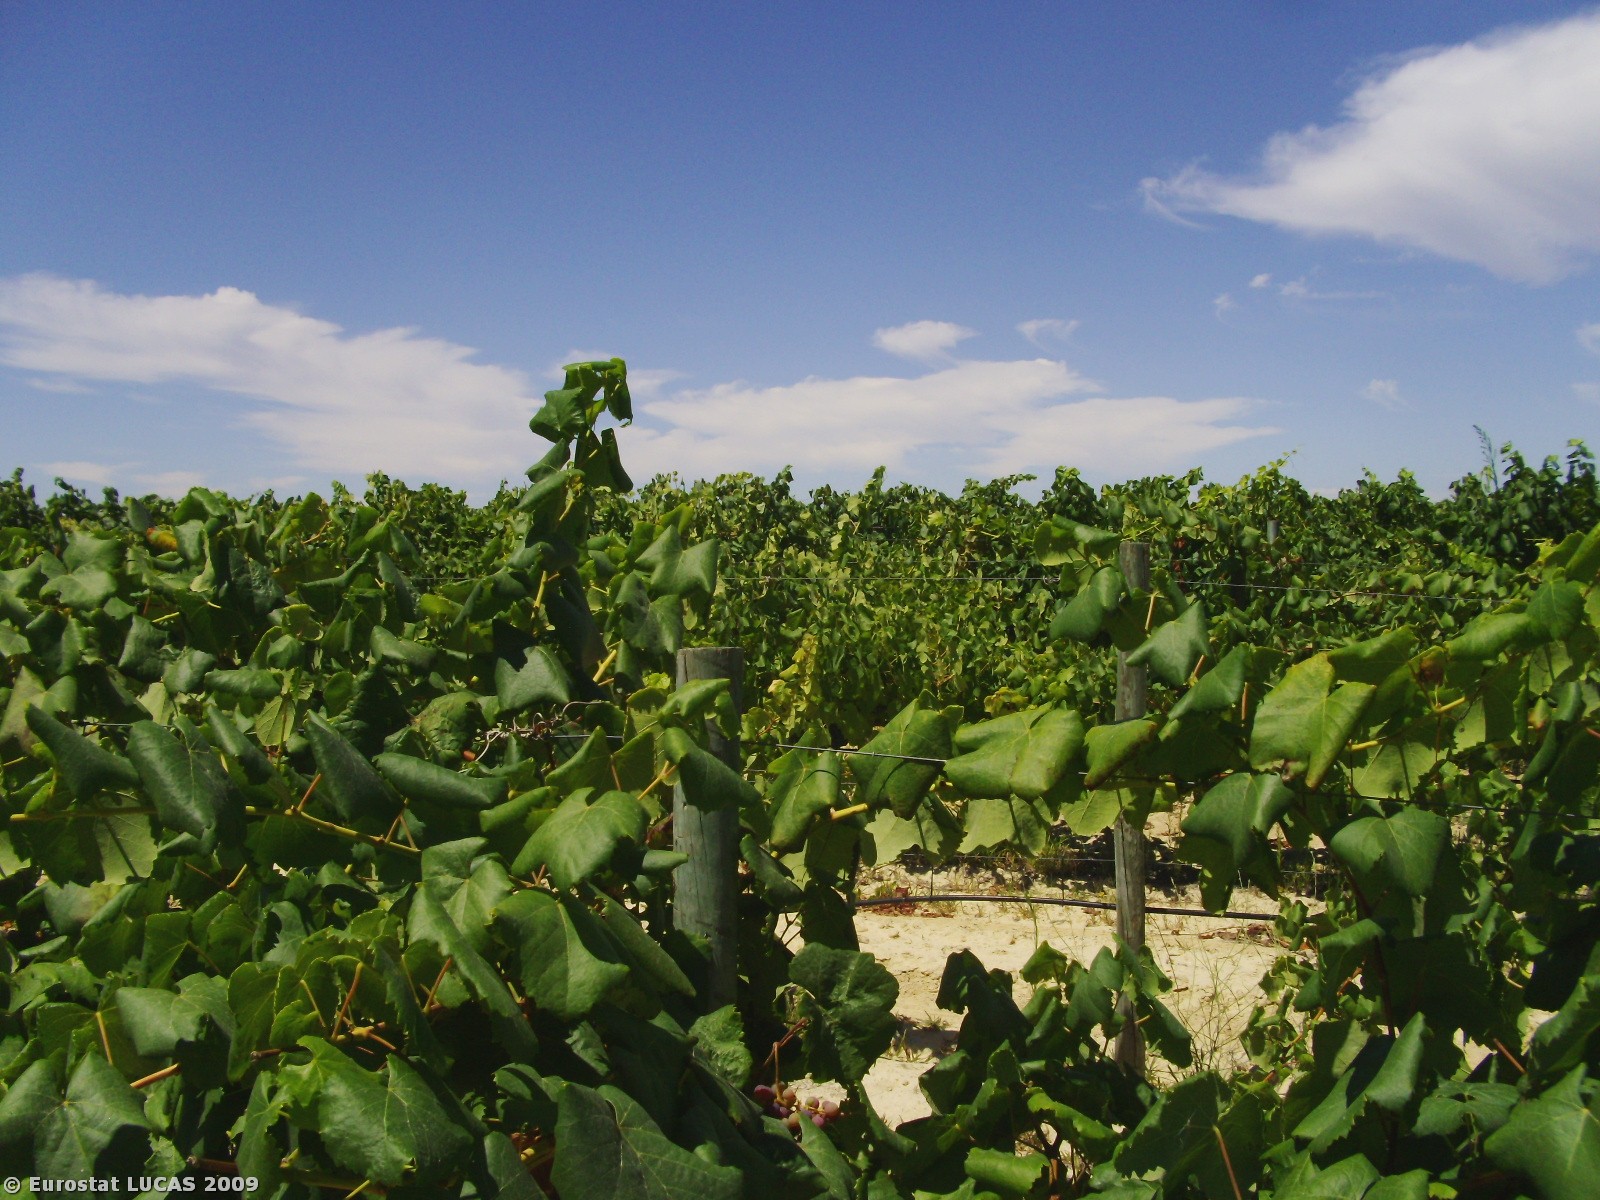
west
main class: Cropland
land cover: Vineyards
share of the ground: 25 - 50 %
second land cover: Bare land
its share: 50 - 75 %
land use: Agriculture (excluding fallow land and kitchen gardens)
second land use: Fallow land
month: August
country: PT
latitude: 38.6614
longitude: -8.6664
